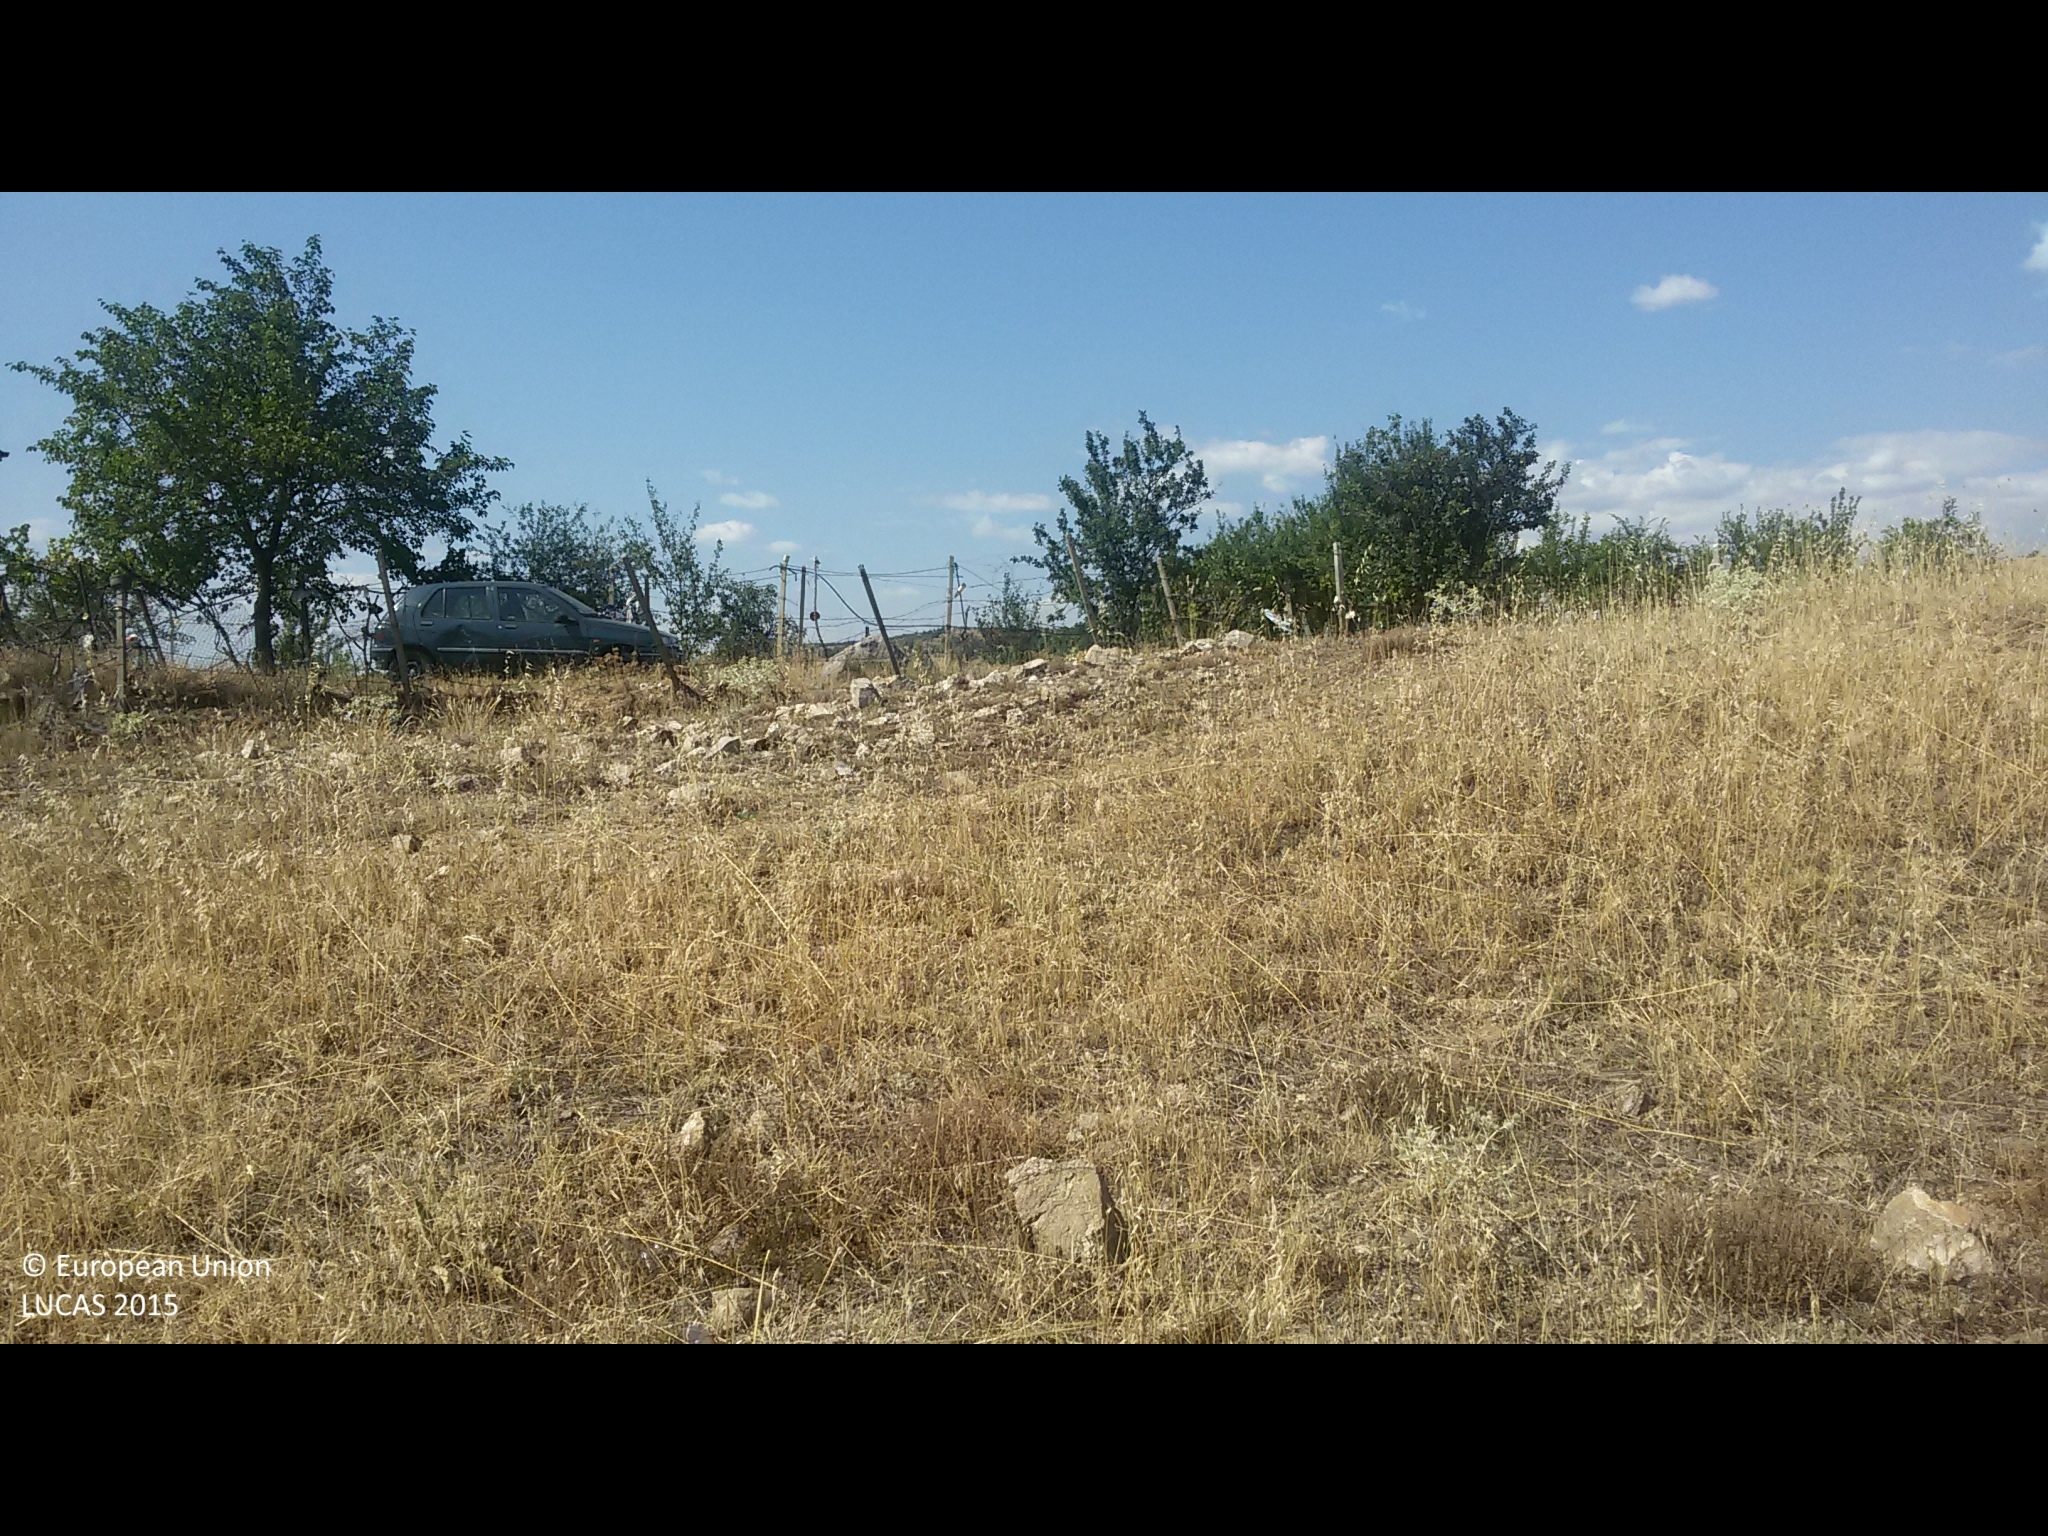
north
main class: Grassland
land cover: Grassland without tree/shrub cover
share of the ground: > 75 %
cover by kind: herbaceous plants 95 %, shrubs 5 %
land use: Agriculture (excluding fallow land and kitchen gardens)
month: August
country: BG
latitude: 41.9972
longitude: 23.1228
